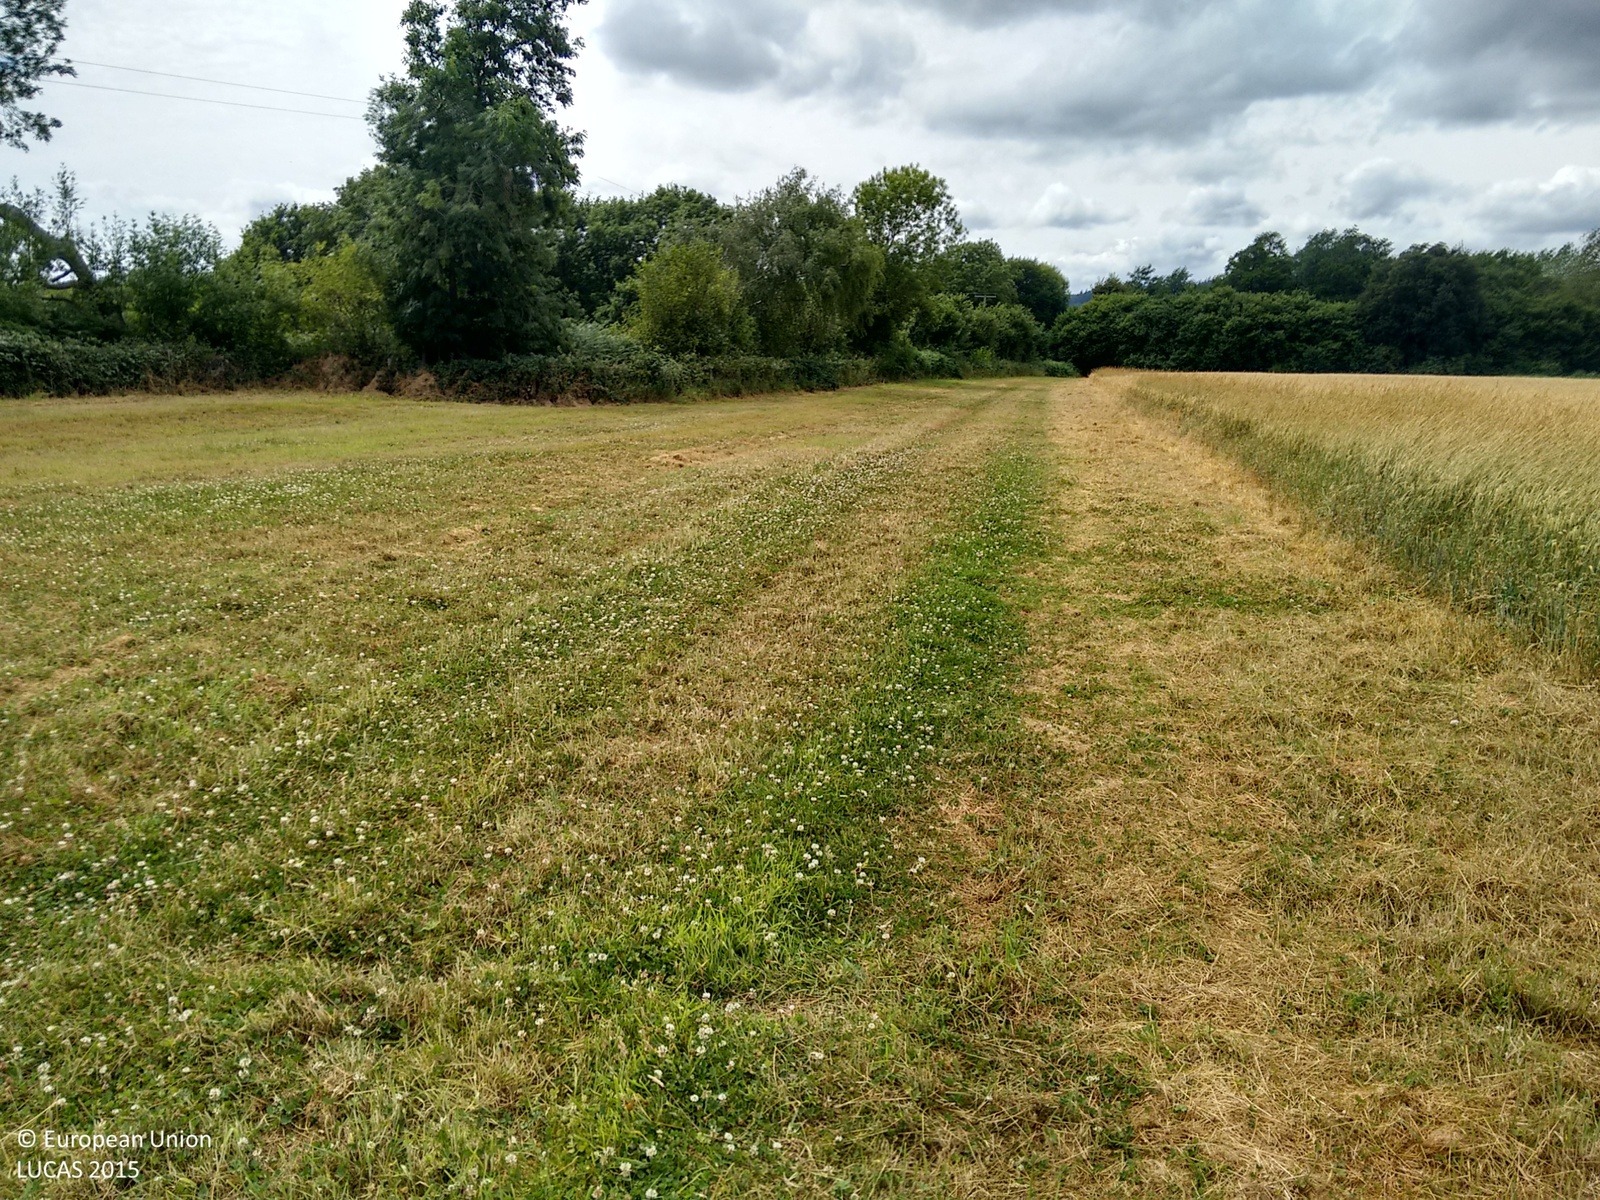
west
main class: Grassland
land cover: Spontaneously vegetated surfaces
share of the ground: > 75 %
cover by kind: herbaceous plants 100 %
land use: Agriculture (excluding fallow land and kitchen gardens)
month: July
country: GB
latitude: 51.1295
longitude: -0.5128
